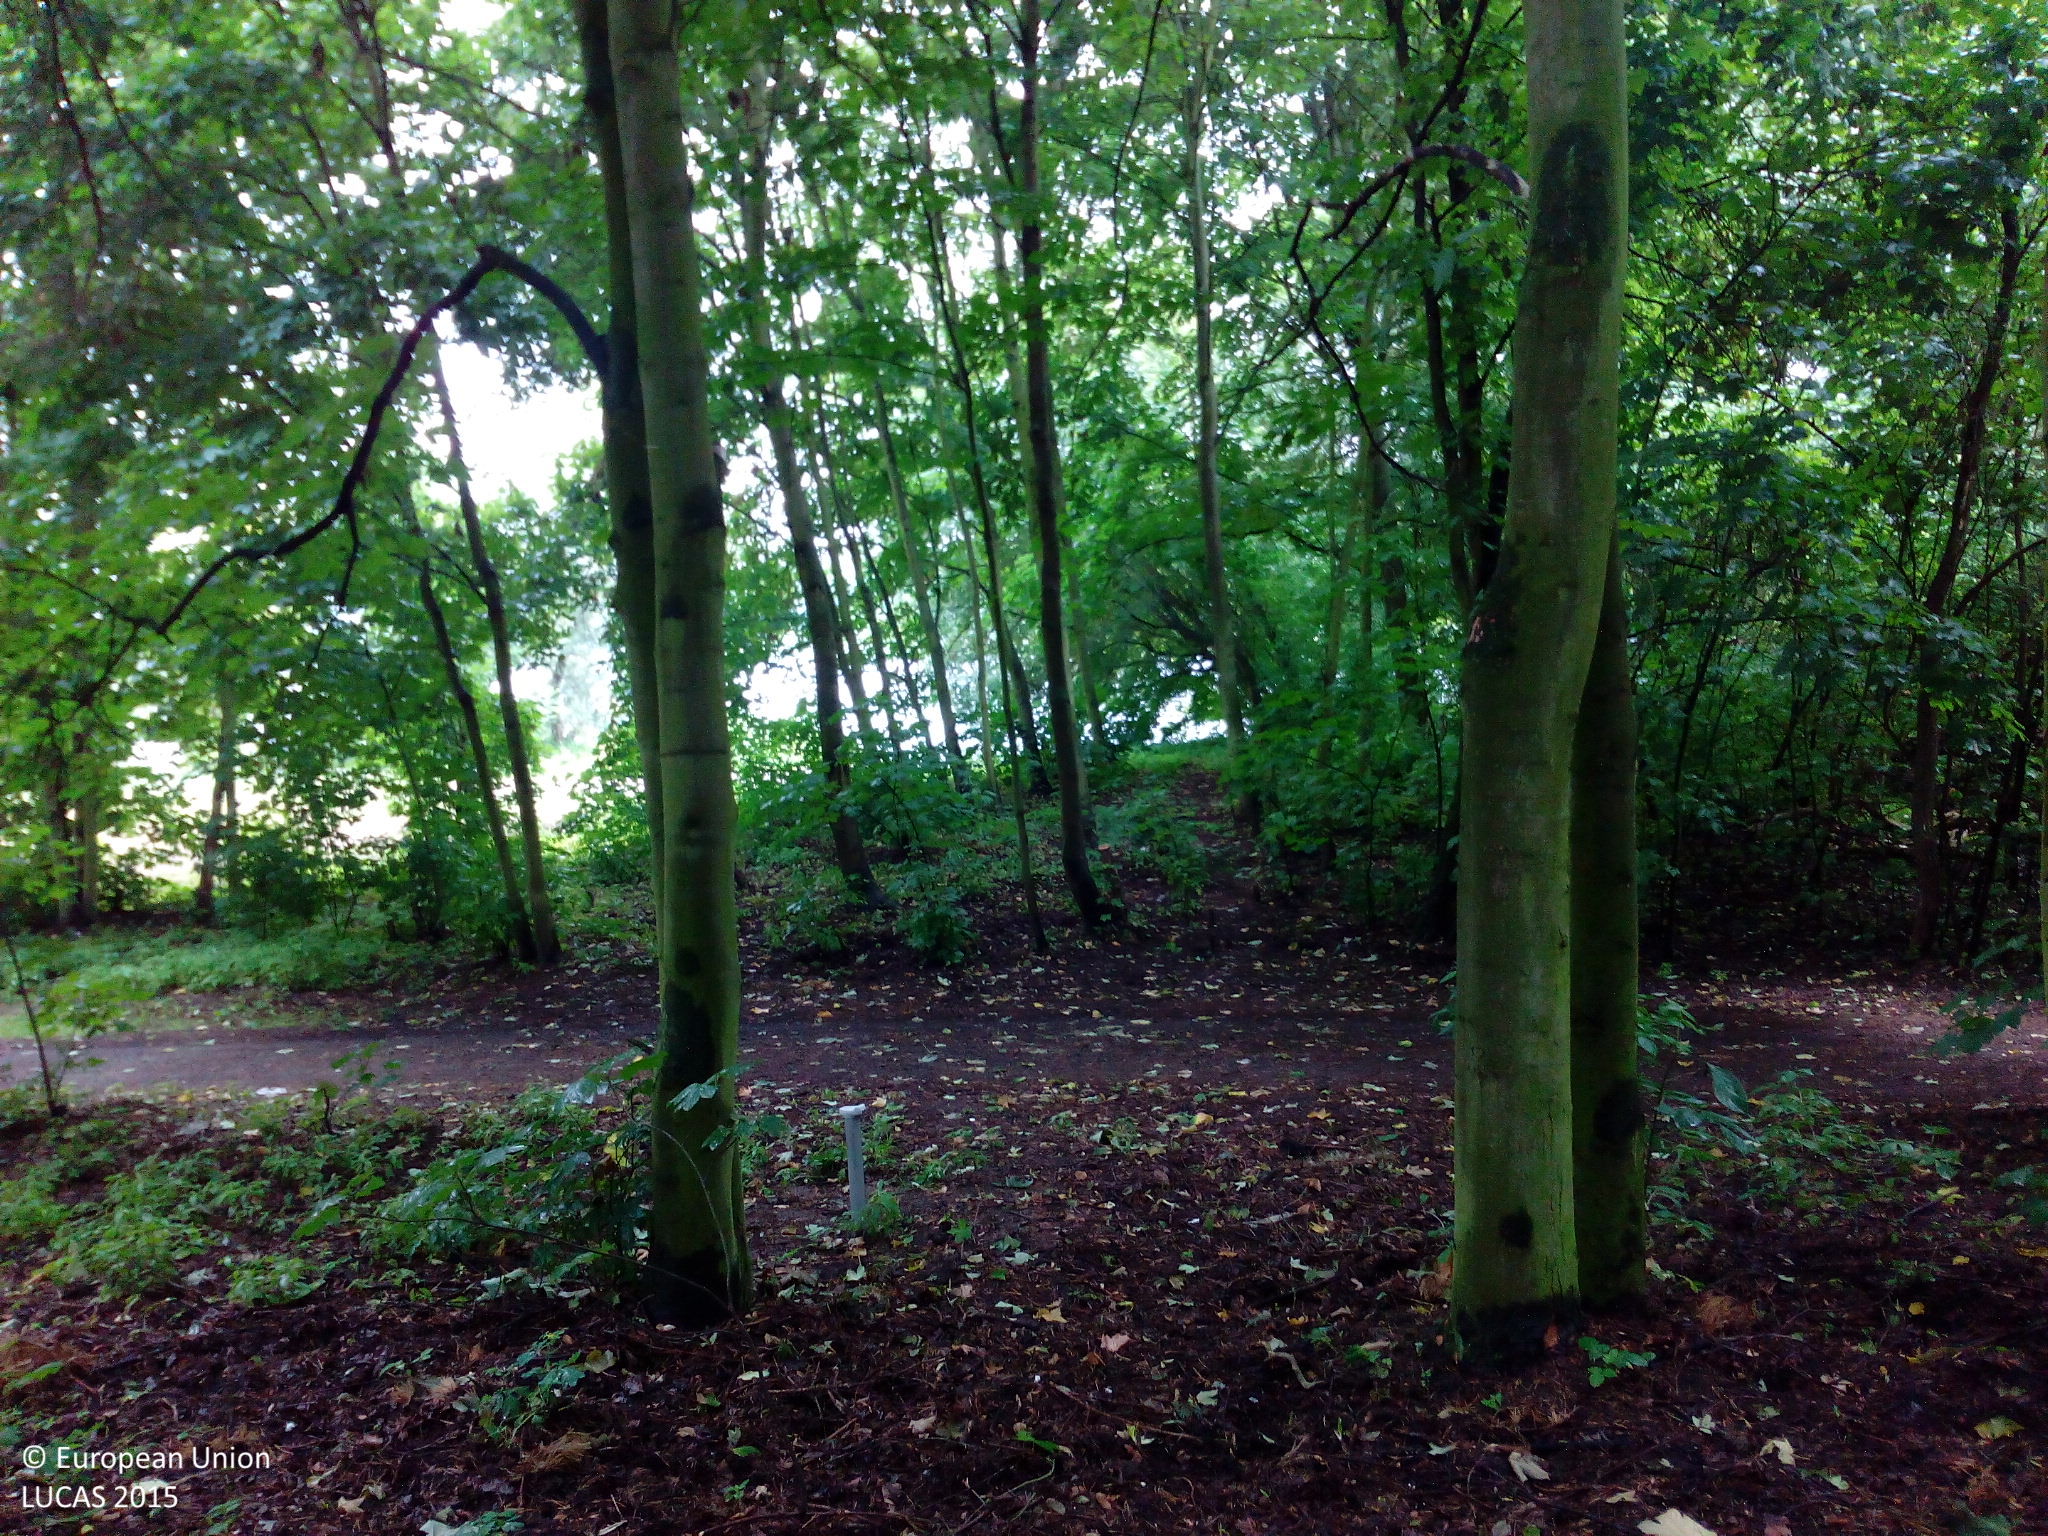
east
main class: Woodland
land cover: Broadleaved woodland
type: mesophytic deciduous forest
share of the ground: > 75 %
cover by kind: broadleaved forest trees 100 %
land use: Forestry
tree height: > 5 m
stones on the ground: < 10 %
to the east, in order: Broadleaved woodland; Tracks; Broadleaved woodland; Inland fresh water bodies
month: July
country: DE
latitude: 52.4964
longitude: 13.1963
